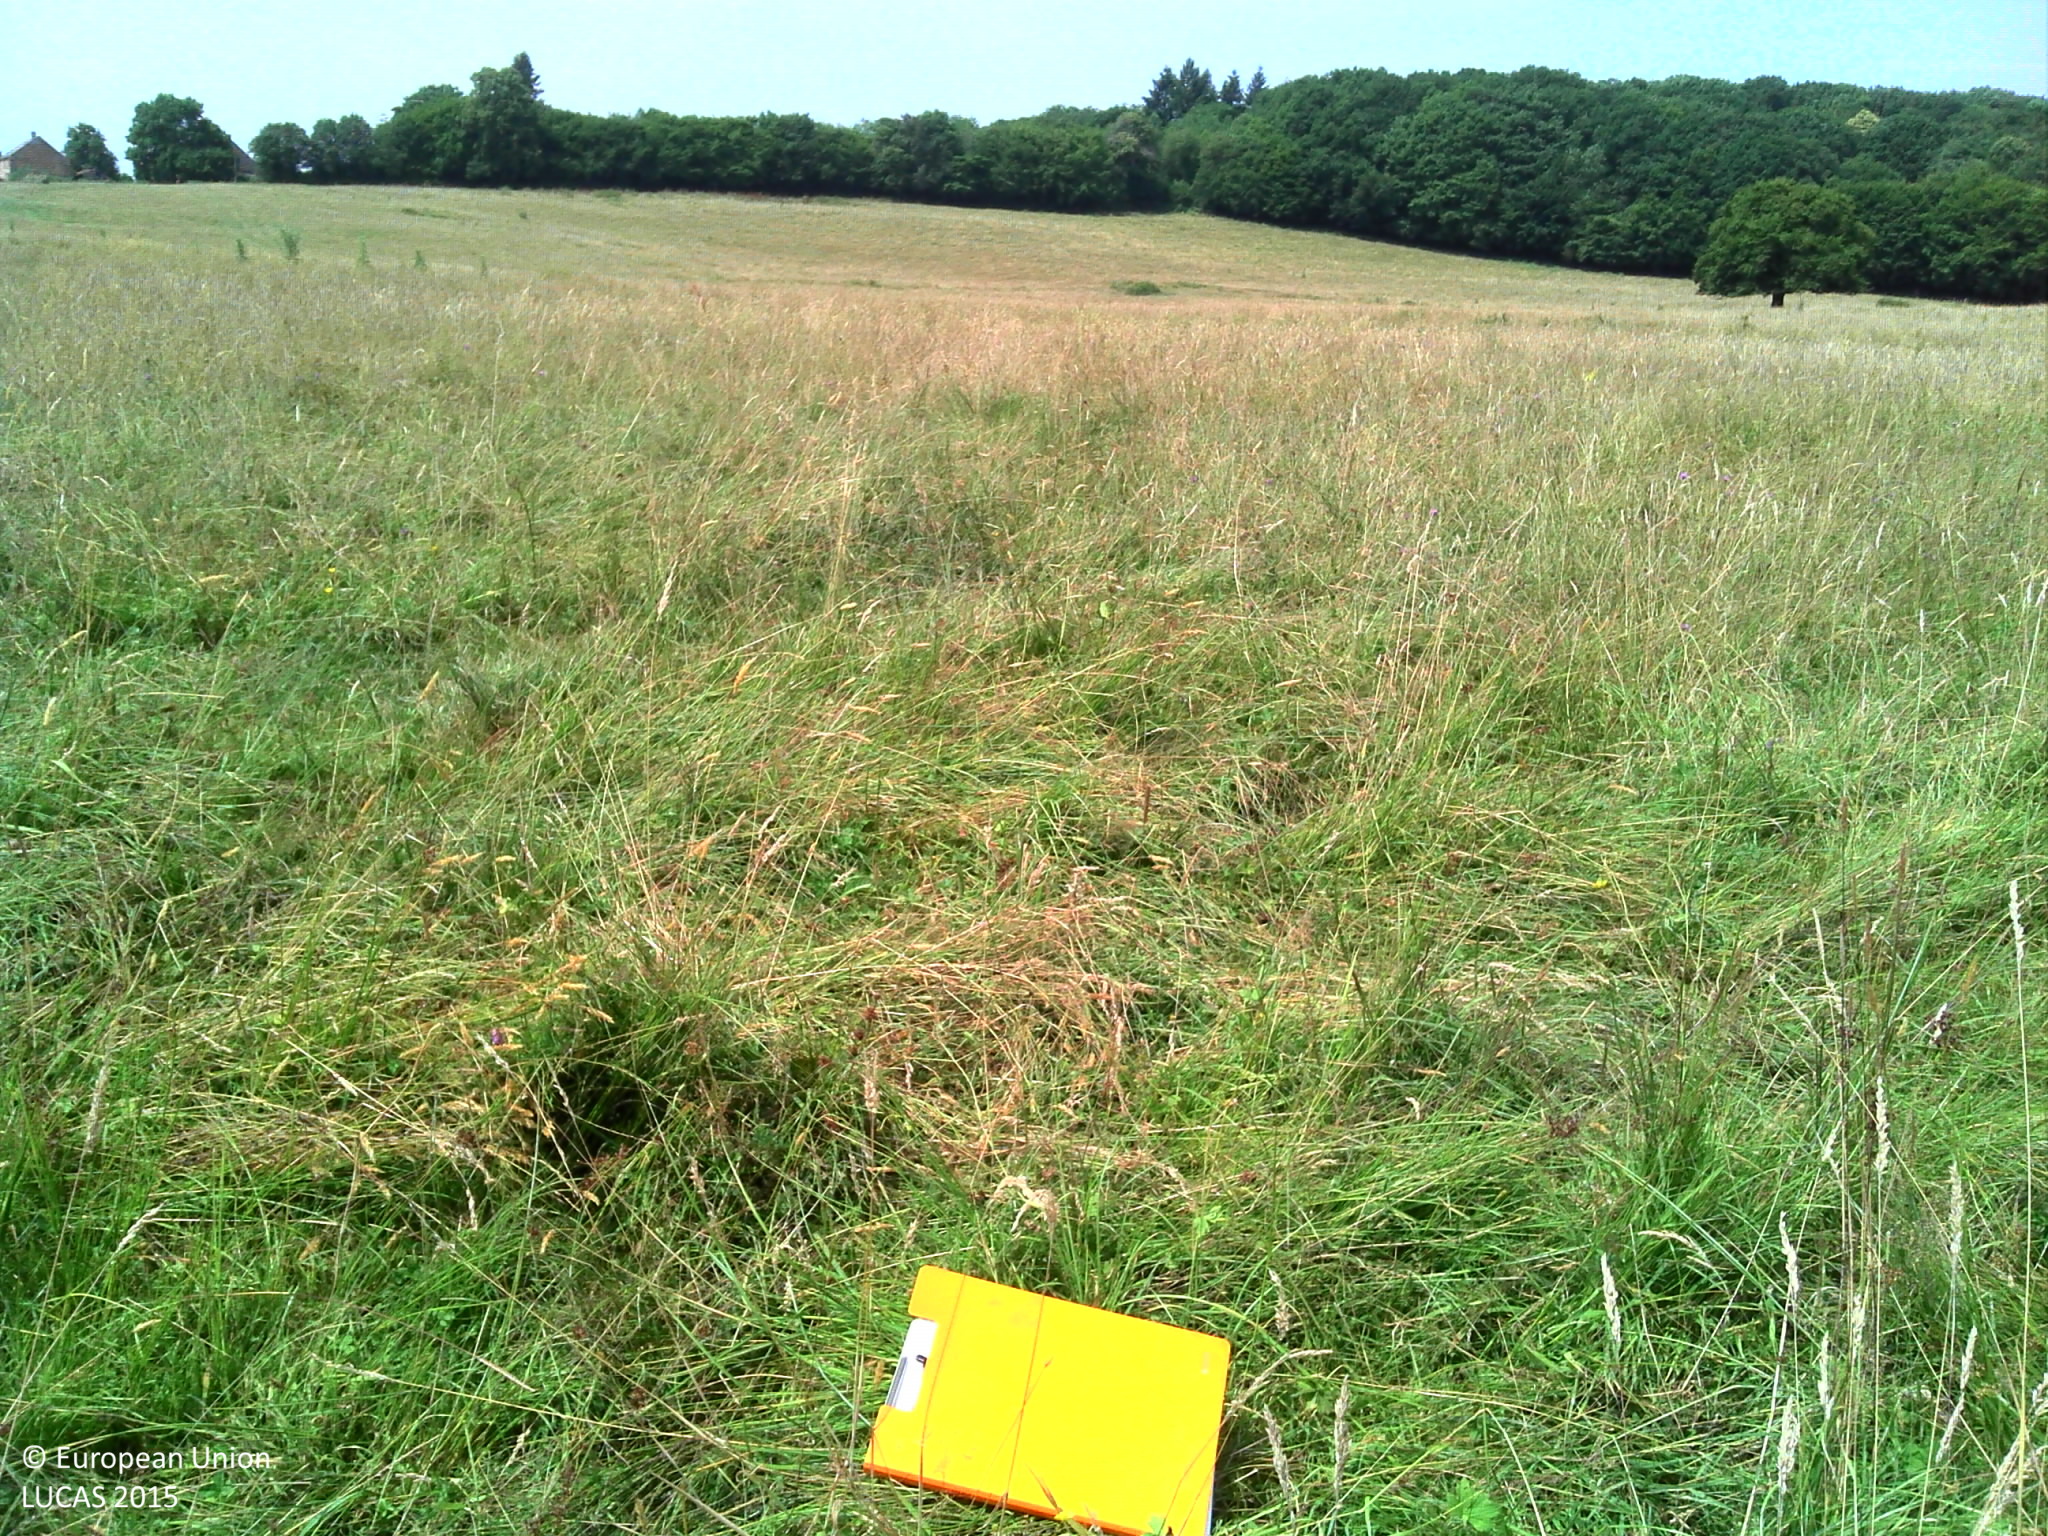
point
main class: Grassland
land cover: Grassland without tree/shrub cover
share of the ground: > 75 %
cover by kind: herbaceous plants 100 %
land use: Agriculture (excluding fallow land and kitchen gardens)
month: July
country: FR
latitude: 47.0766
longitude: 3.5310
